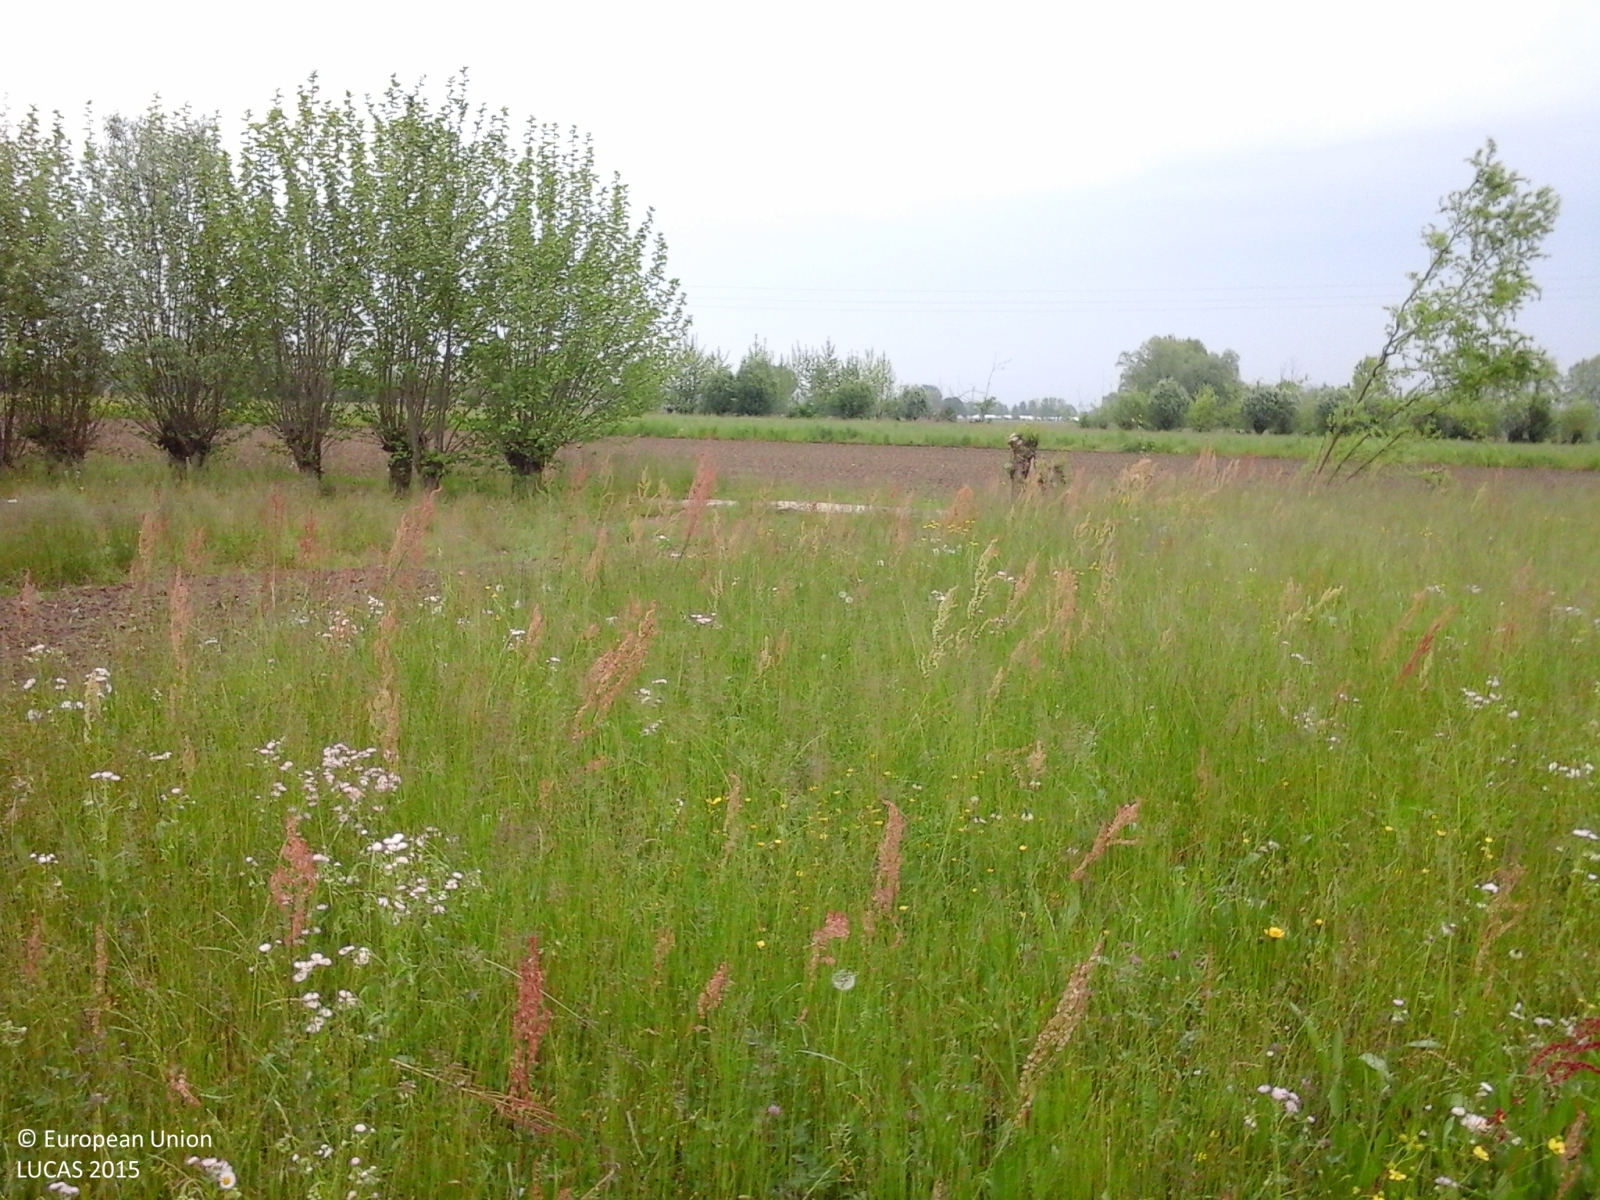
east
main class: Grassland
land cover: Grassland without tree/shrub cover
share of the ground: > 75 %
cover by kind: herbaceous plants 100 %
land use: Agriculture (excluding fallow land and kitchen gardens)
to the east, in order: Grassland without tree/shrub cover; Maize; Grass margins; Managed hedges; Ditches and canals; Managed hedges; Maize; Grass margins; Managed hedges; Ditches and canals; Managed hedges; Grass margins; Electric lines; Tracks; Grassland without tree/shrub cover
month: May
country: IT
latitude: 45.5448
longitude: 11.7007
